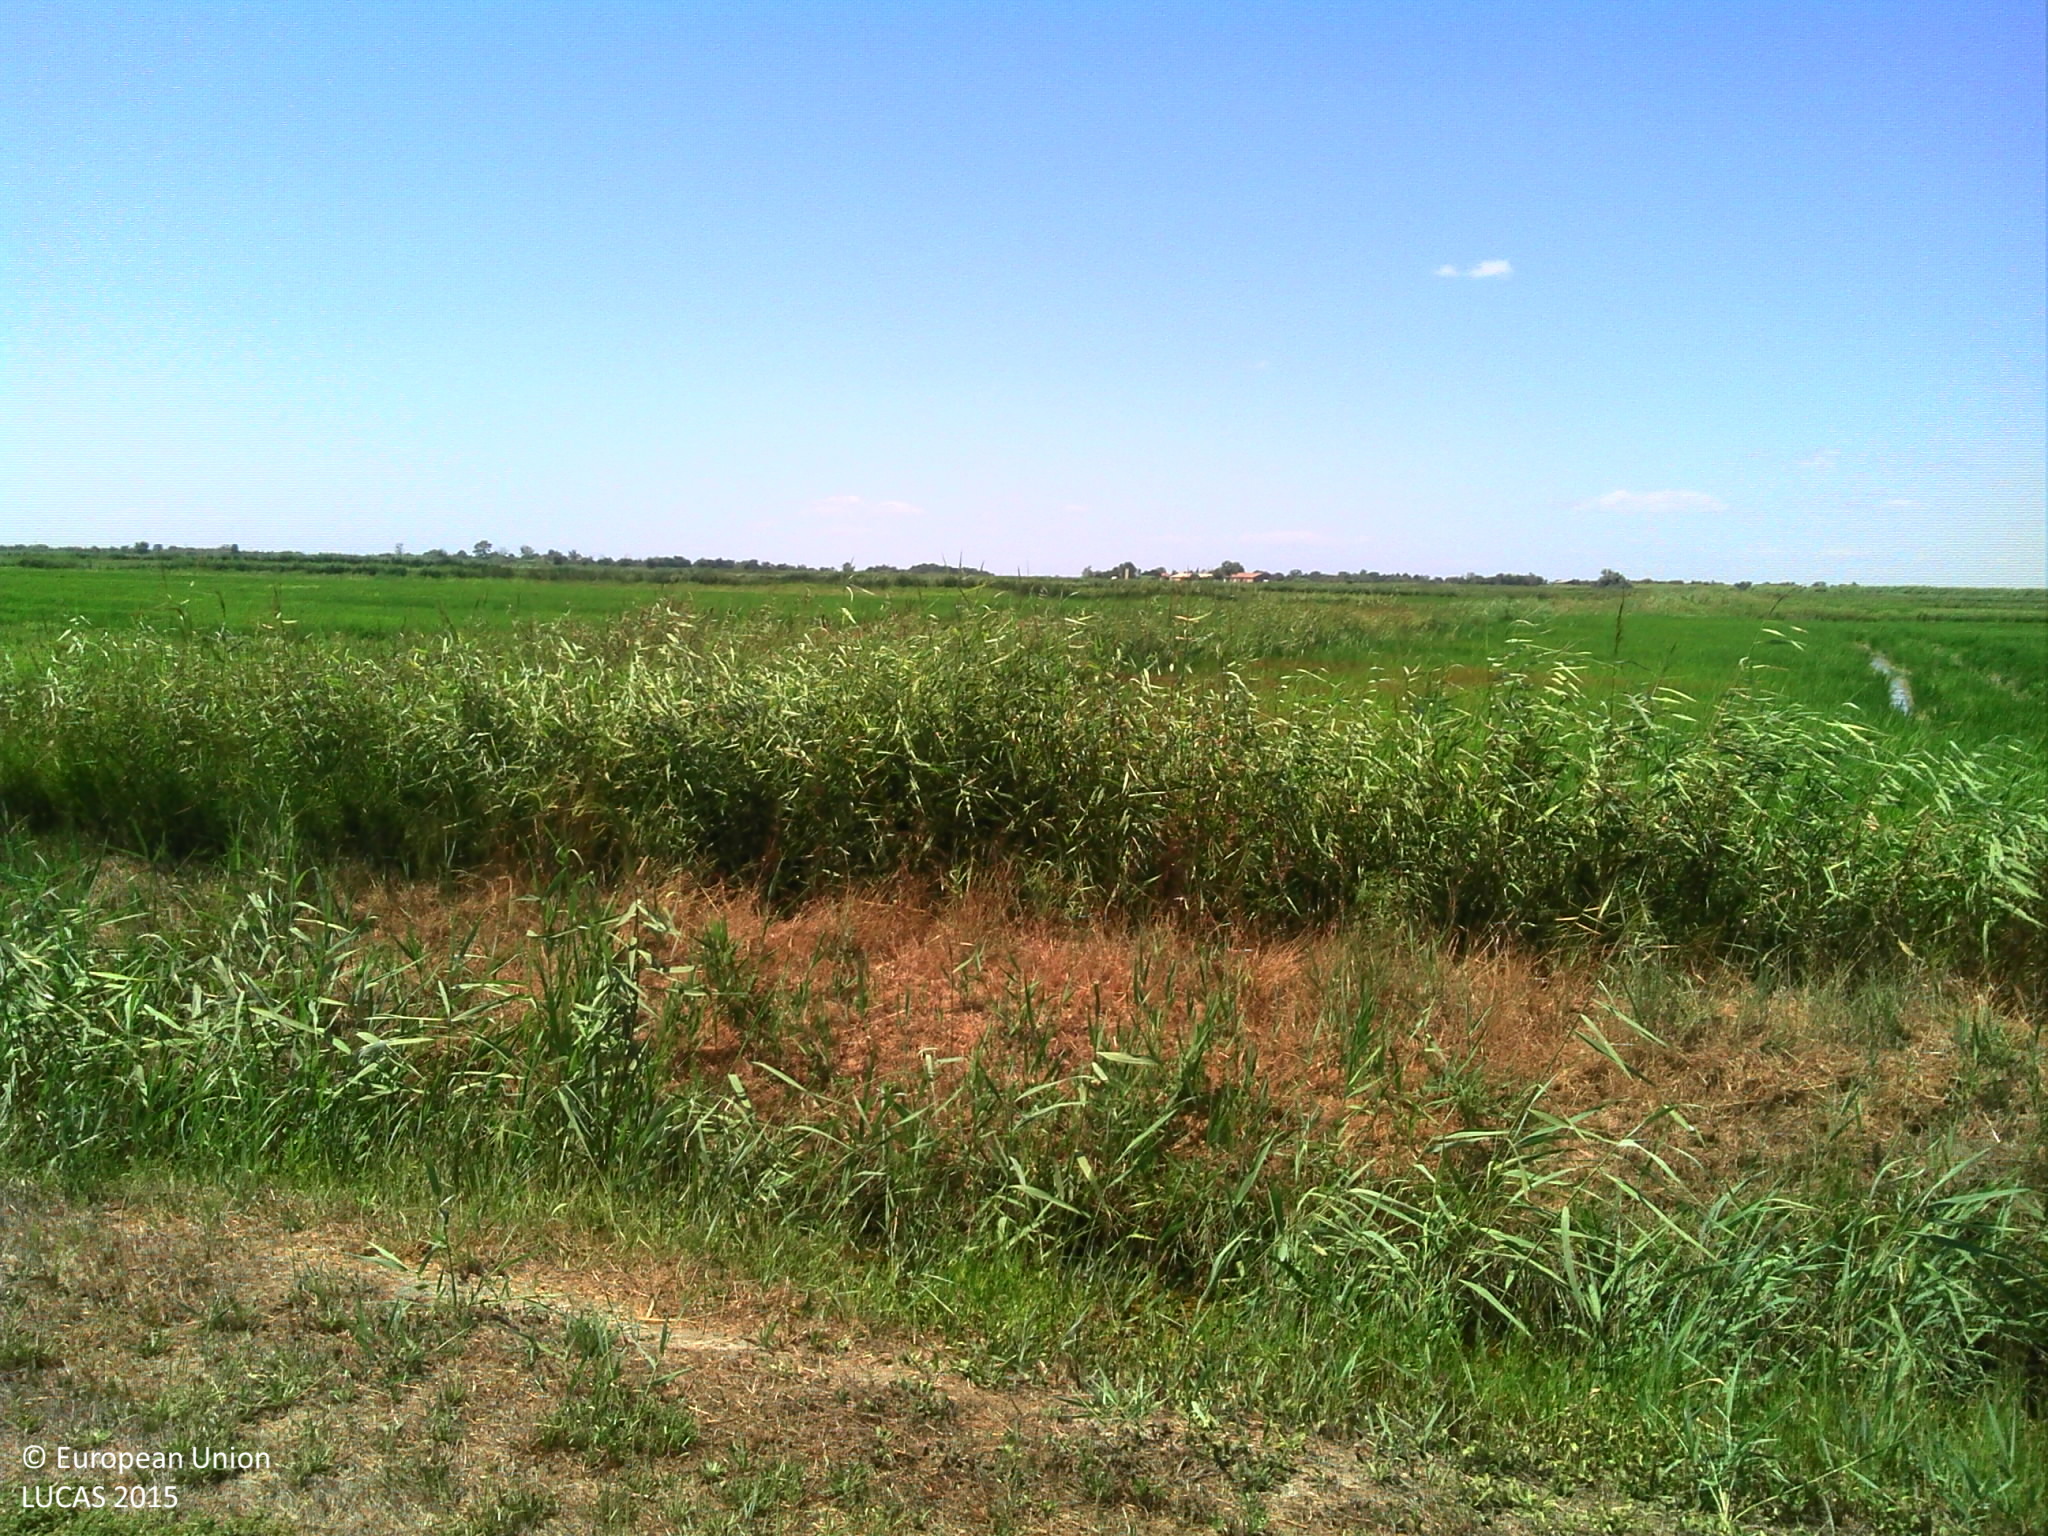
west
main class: Cropland
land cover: Rice
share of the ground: > 75 %
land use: Agriculture (excluding fallow land and kitchen gardens)
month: July
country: FR
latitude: 43.4203
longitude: 4.7116
